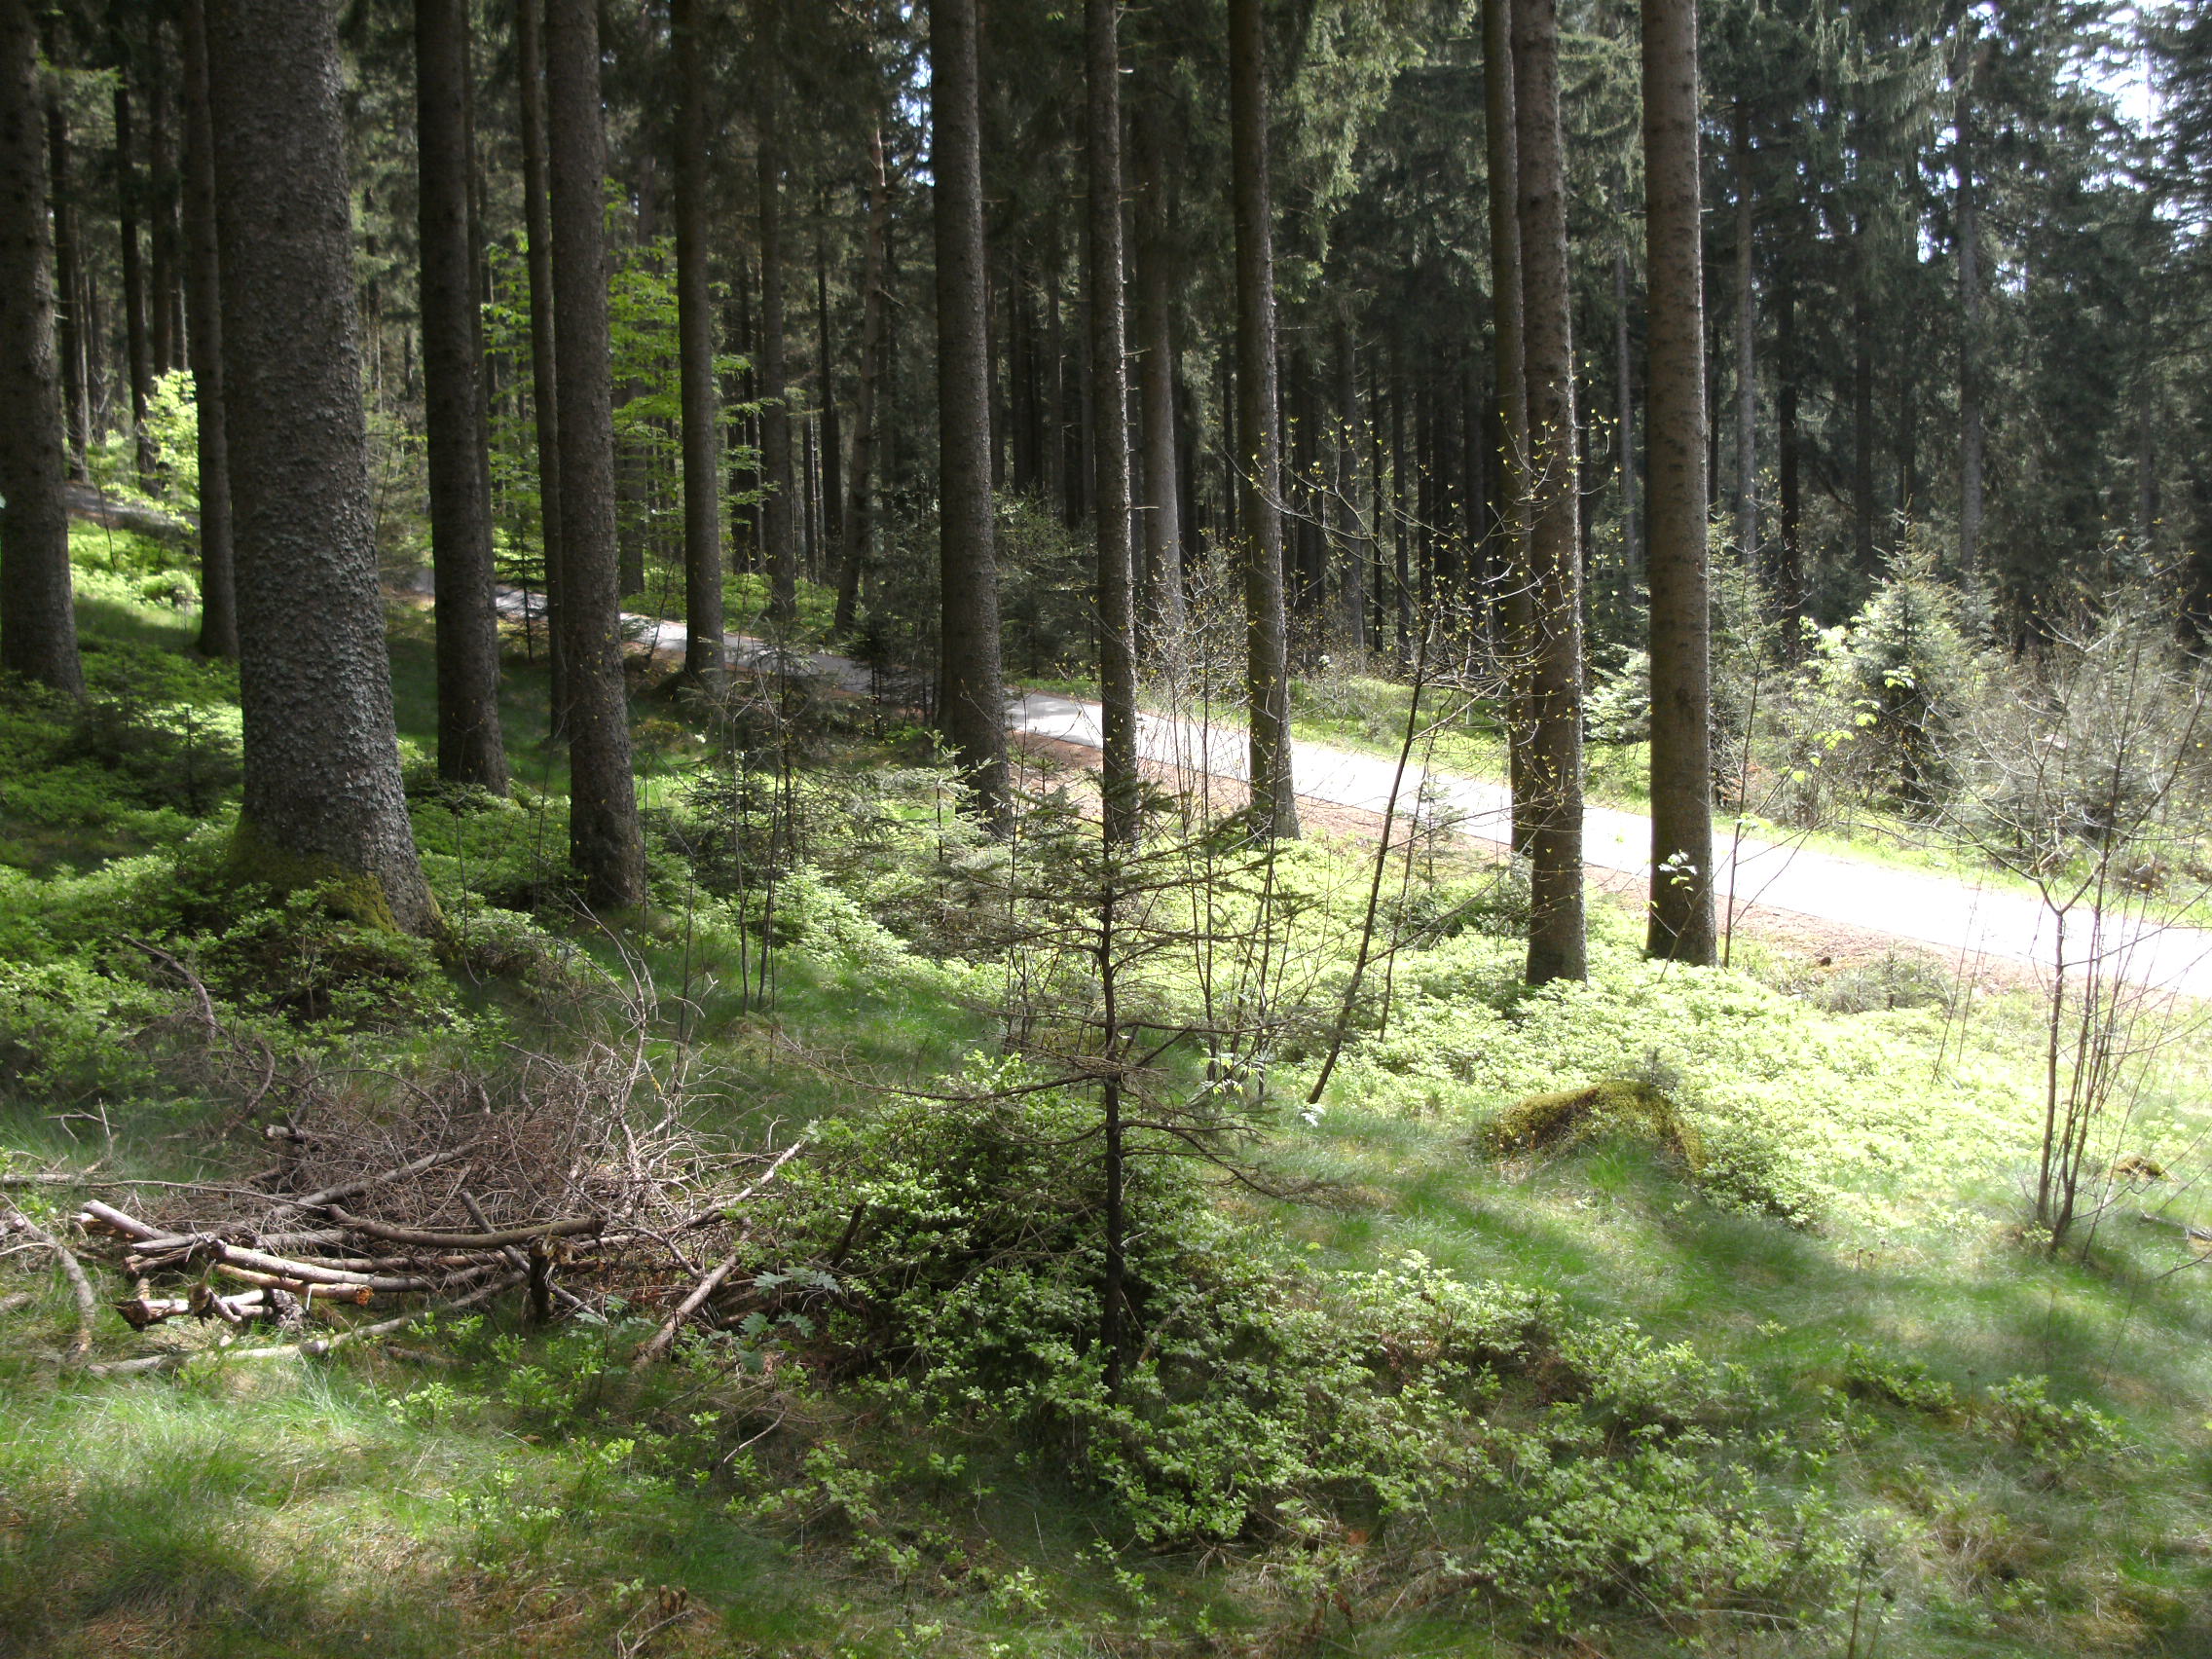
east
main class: Woodland
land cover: Spruce dominated coniferous woodland
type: hemiboreal forest and nemoral coniferous forest and mixed broadleaved-coniferous forest
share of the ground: 50 - 75 %
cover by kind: coniferous forest trees 70 %, herbaceous plants 20 %, shrubs 10 %
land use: Forestry
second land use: Sport
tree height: > 5 m
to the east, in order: Spruce dominated coniferous woodland; Paved roads, cycling and walking lanes; Other coniferous woodland; Spruce dominated coniferous woodland; Tracks; Spruce dominated coniferous woodland; Tracks; Spruce dominated coniferous woodland; Paved roads, cycling and walking lanes; Grass margins; Abandoned hedges; Ditches and canals; Shrubland without tree cover; Grassland with sparse tree/shrub cover
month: May
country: AT
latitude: 48.1000
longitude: 13.3696
